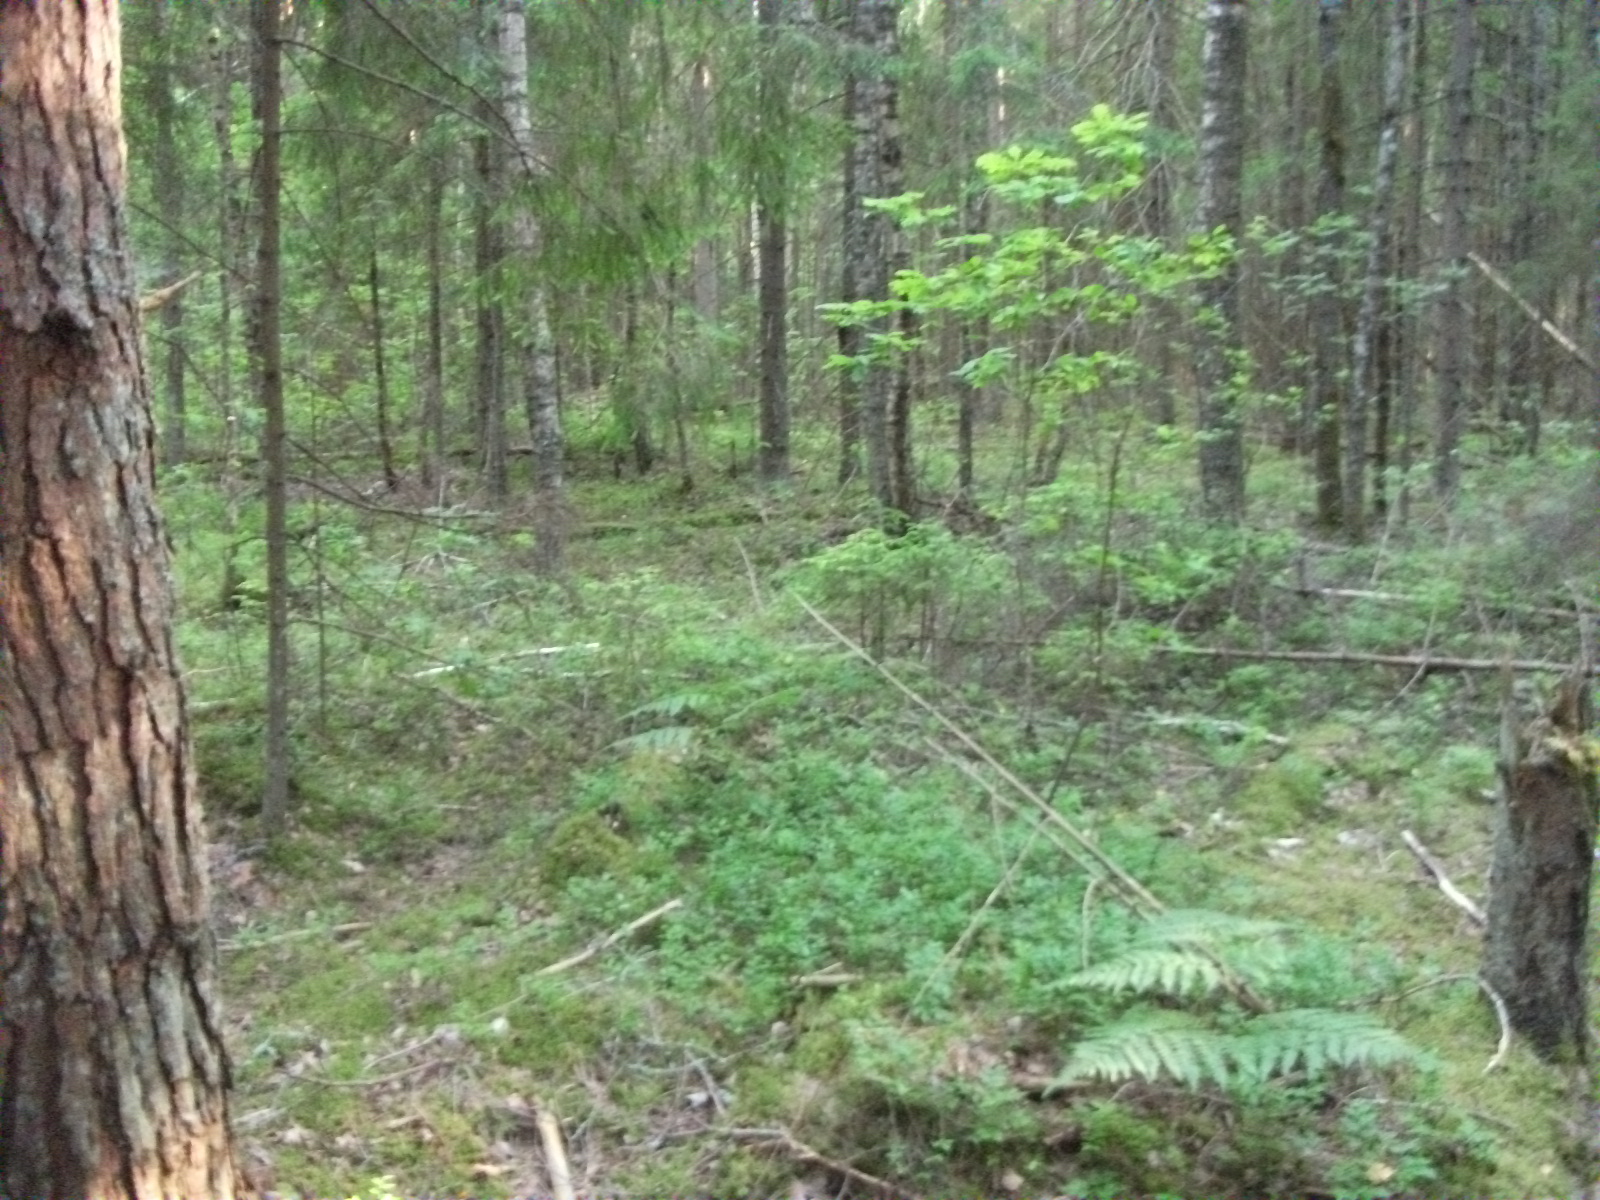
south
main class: Woodland
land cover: Spruce dominated coniferous woodland
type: hemiboreal forest and nemoral coniferous forest and mixed broadleaved-coniferous forest
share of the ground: > 75 %
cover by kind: coniferous forest trees 85 %, shrubs 10 %, broadleaved forest trees 5 %
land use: Forestry
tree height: > 5 m
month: July
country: LV
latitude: 56.8193
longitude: 26.6487
